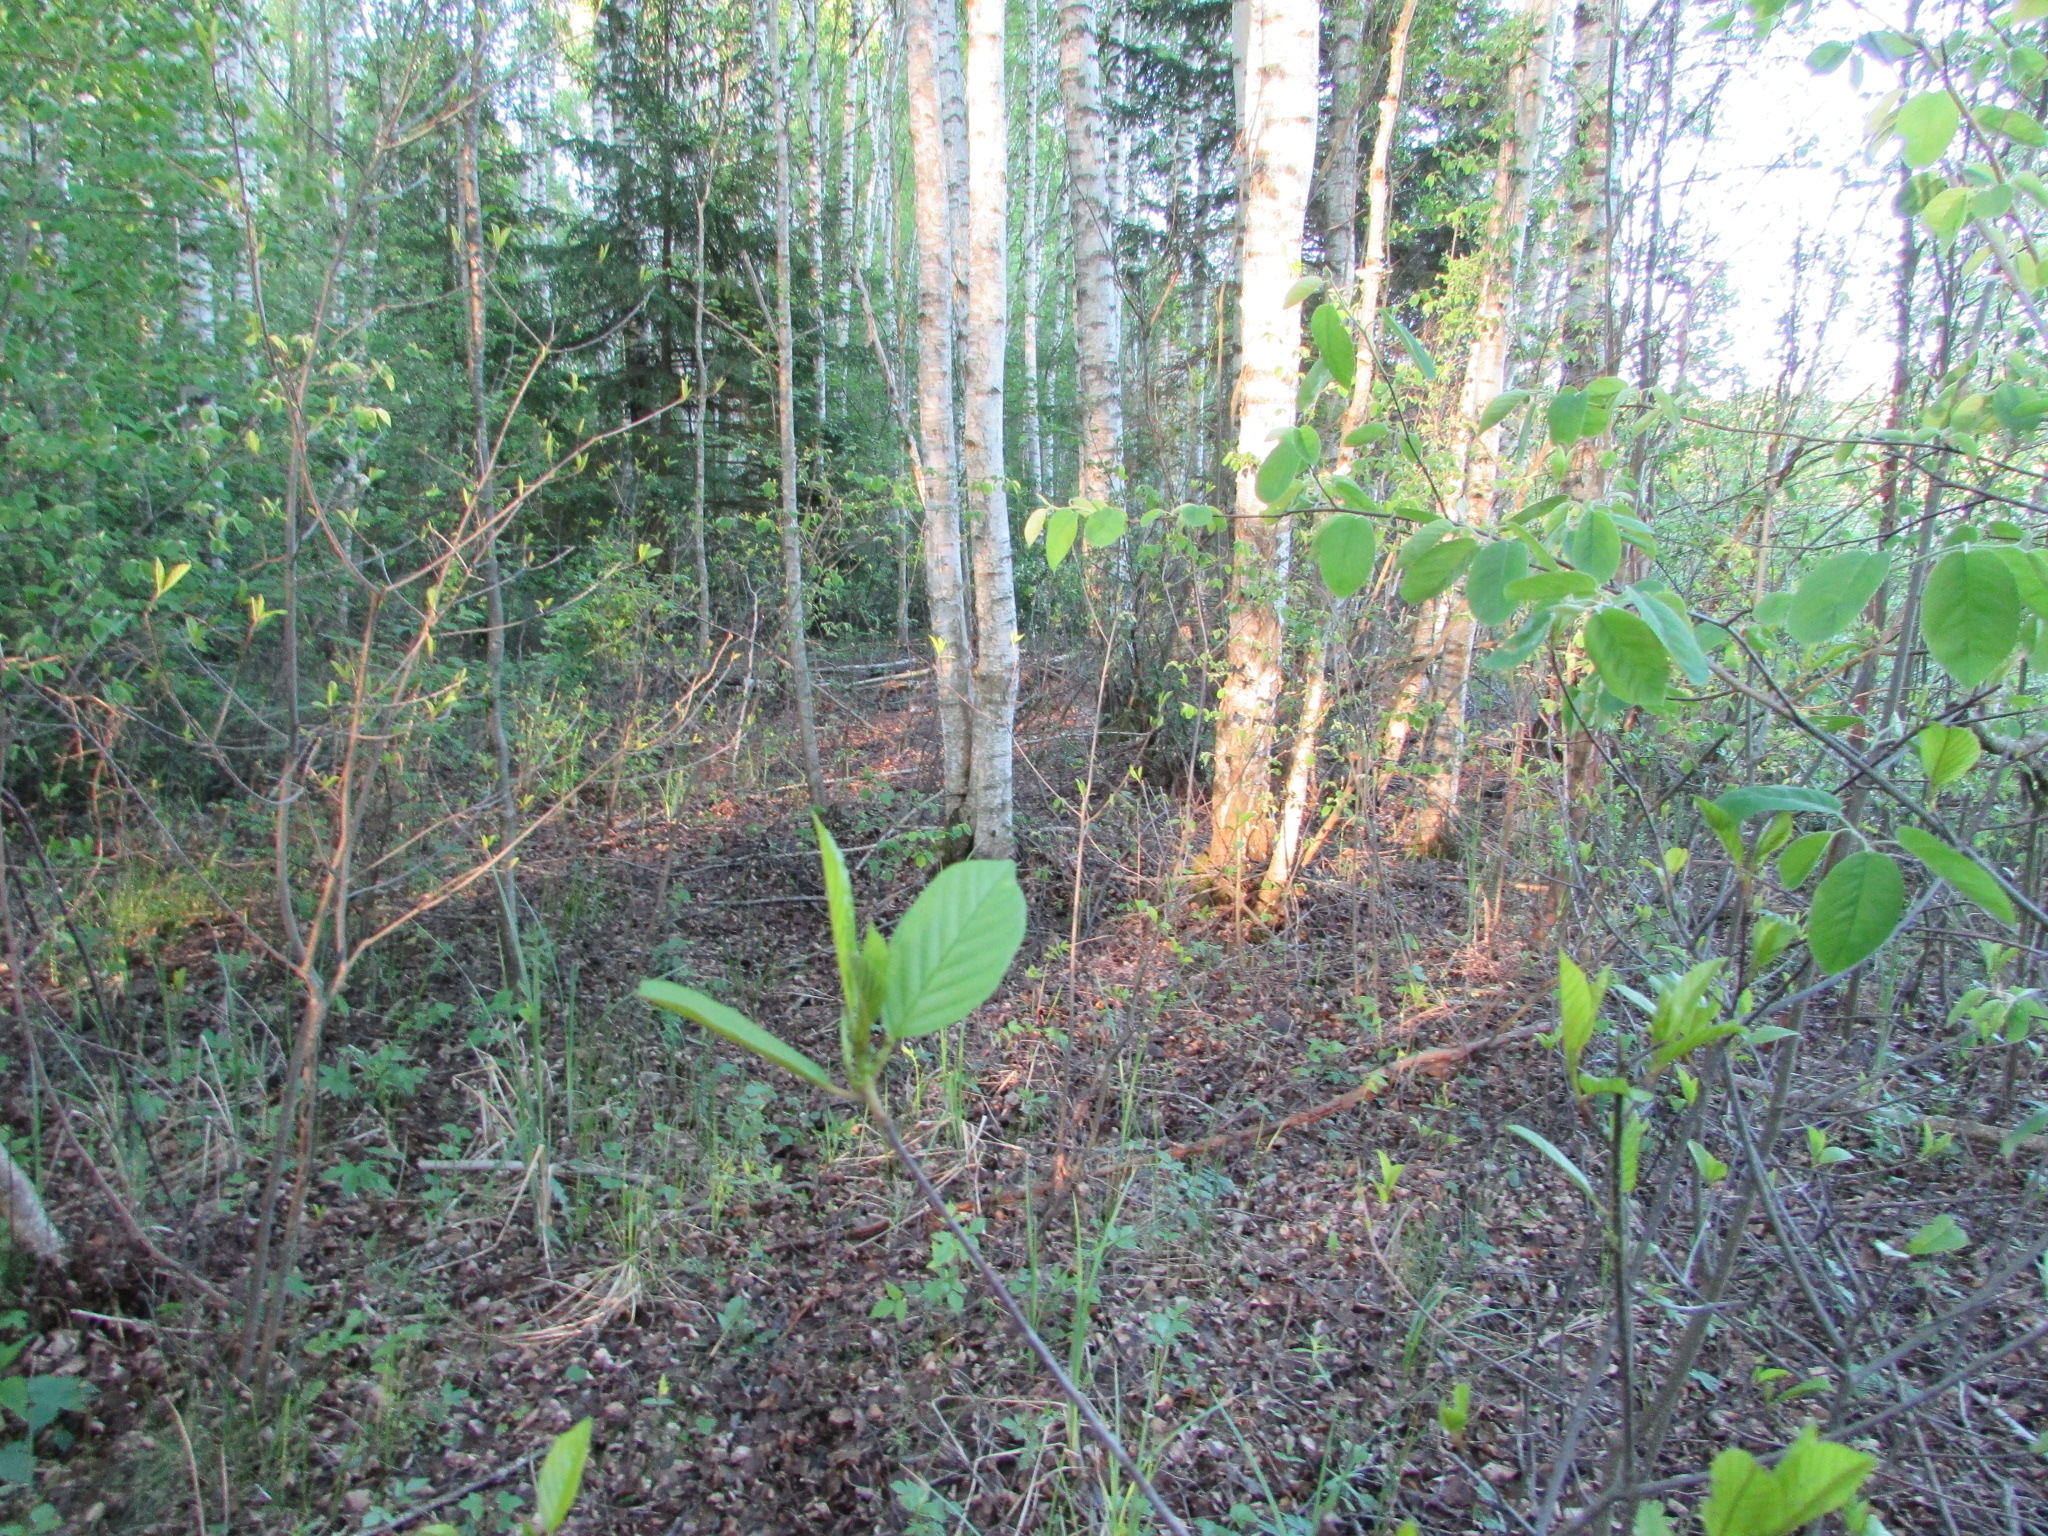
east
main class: Woodland
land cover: Broadleaved woodland
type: non-riverine alder, birch or aspen forest
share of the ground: > 75 %
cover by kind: broadleaved forest trees 100 %
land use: Forestry
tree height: > 5 m
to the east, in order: Broadleaved woodland; Spruce dominated mixed woodland; Pine dominated mixed woodland; Paved roads, cycling and walking lanes; Grassland with sparse tree/shrub cover; Pine dominated mixed woodland
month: May
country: LV
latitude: 56.1966
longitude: 27.1732
